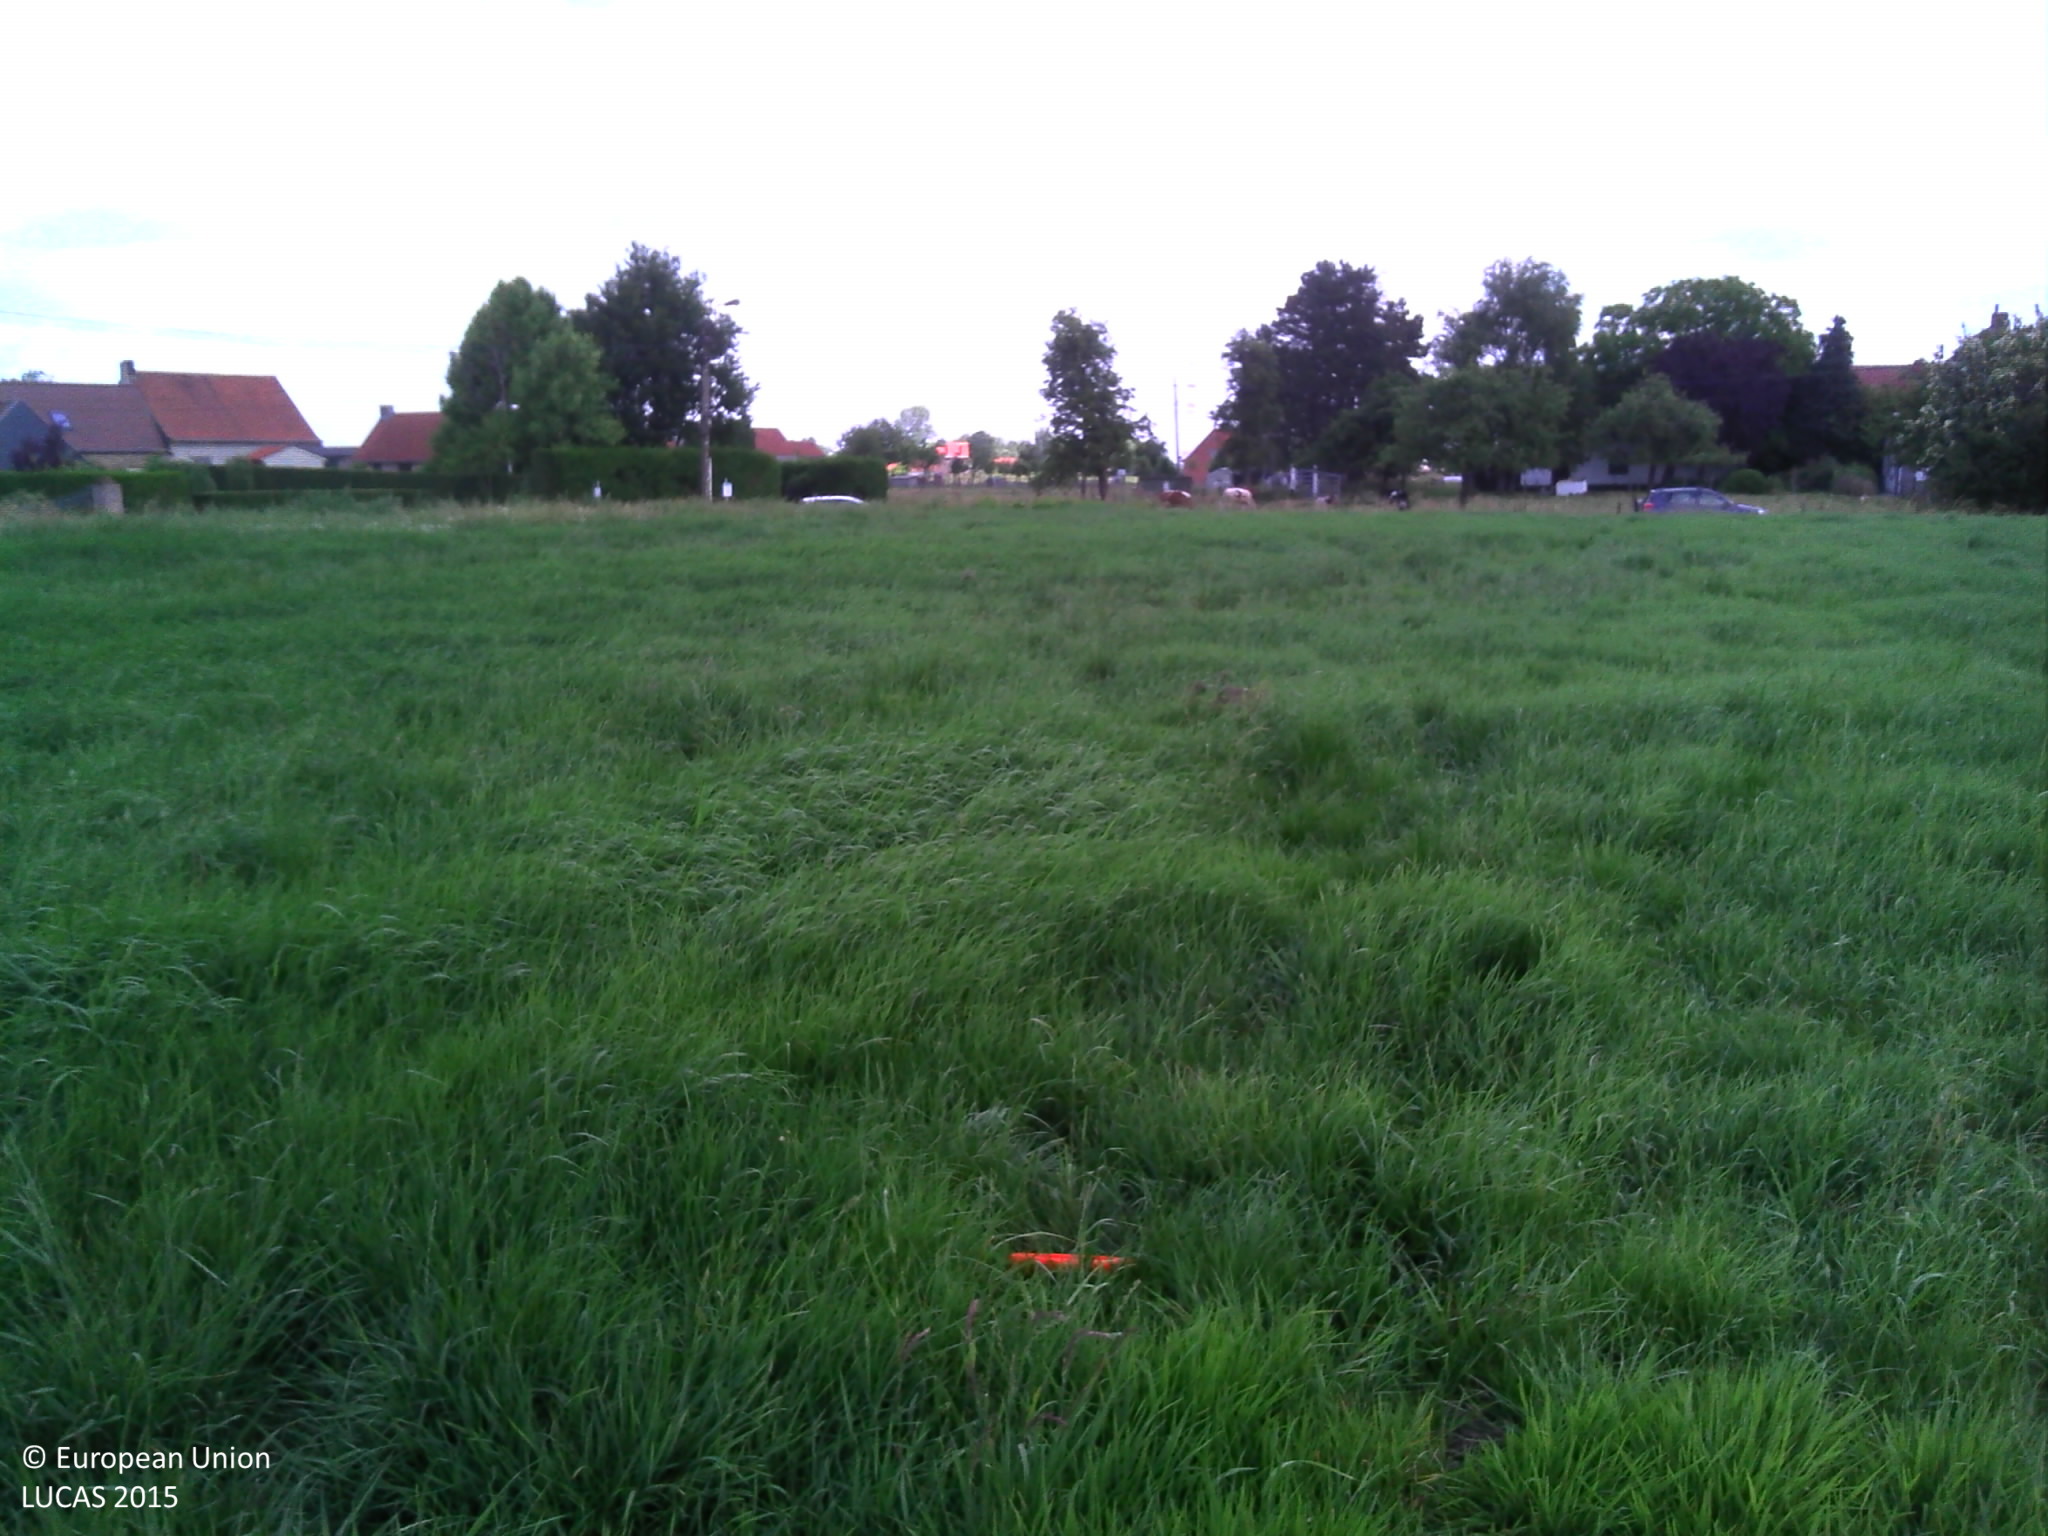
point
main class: Grassland
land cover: Grassland without tree/shrub cover
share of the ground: > 75 %
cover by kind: herbaceous plants 100 %
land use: Agriculture (excluding fallow land and kitchen gardens)
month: June
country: BE
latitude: 51.1215
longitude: 3.5776
